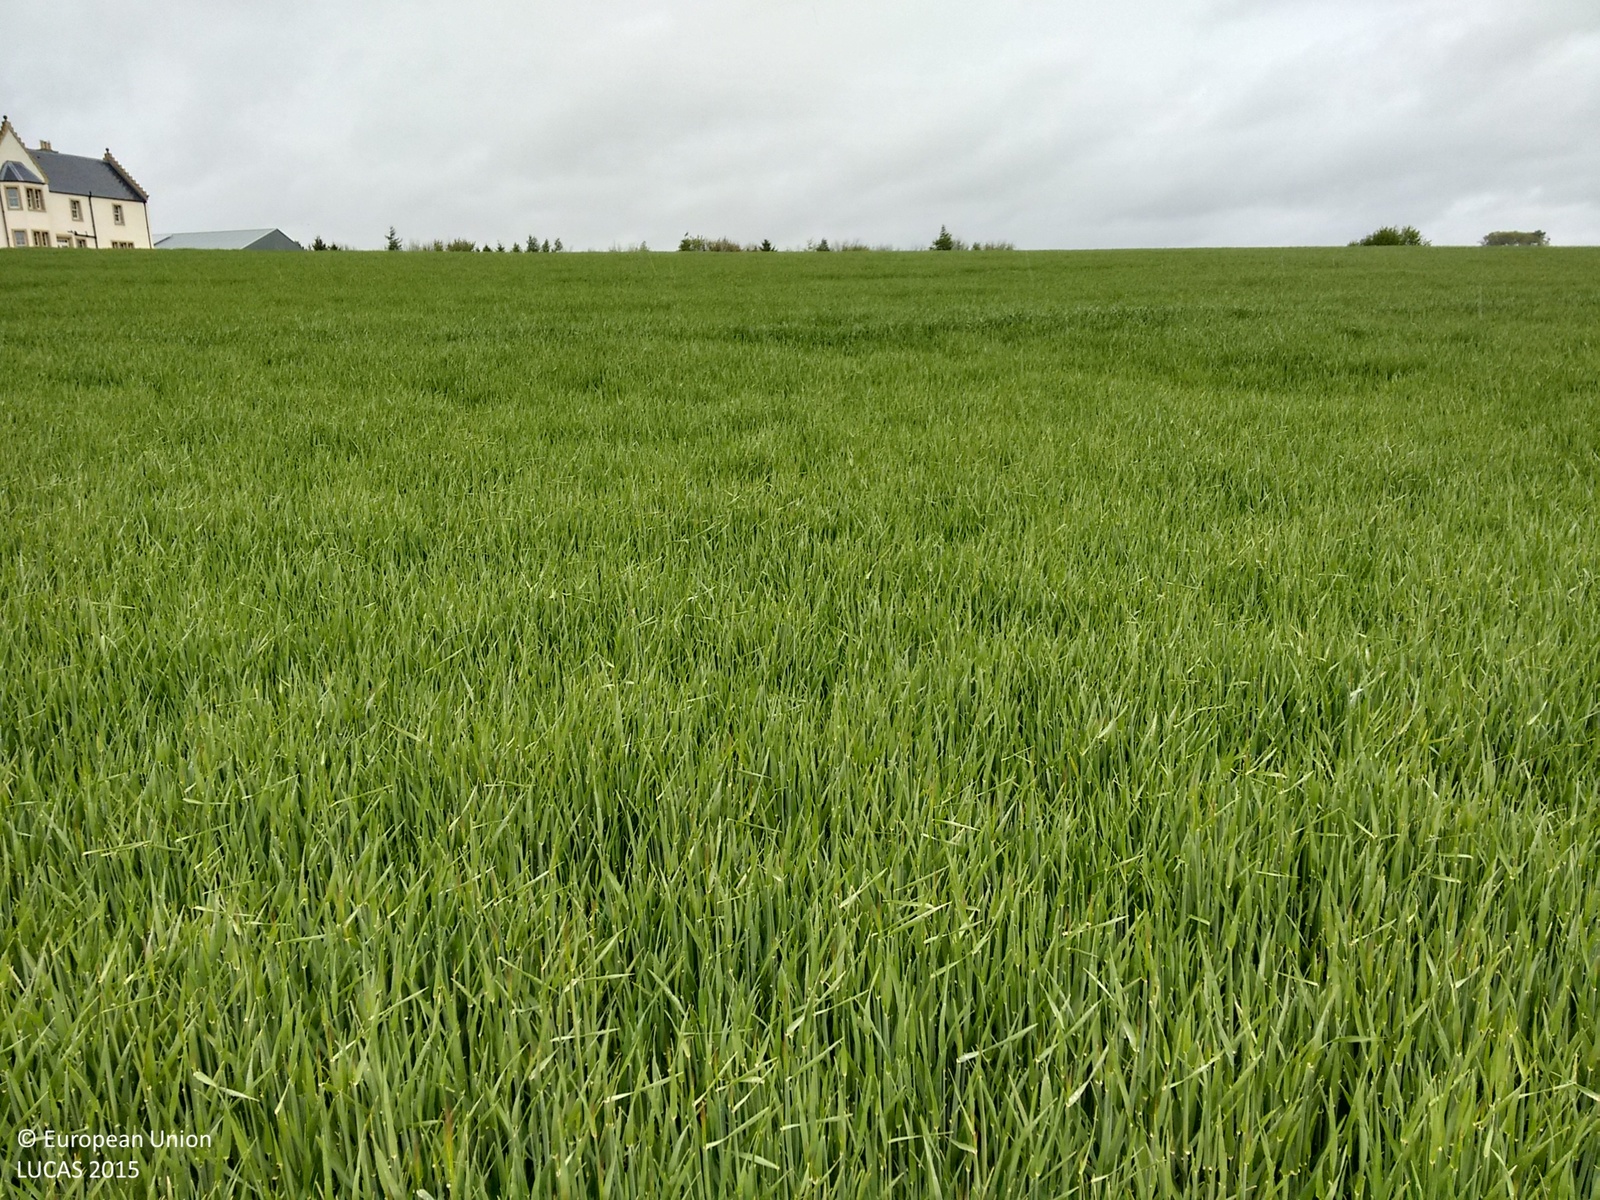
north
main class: Cropland
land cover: Barley
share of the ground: > 75 %
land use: Agriculture (excluding fallow land and kitchen gardens)
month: May
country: GB
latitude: 55.7469
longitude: -2.4048
